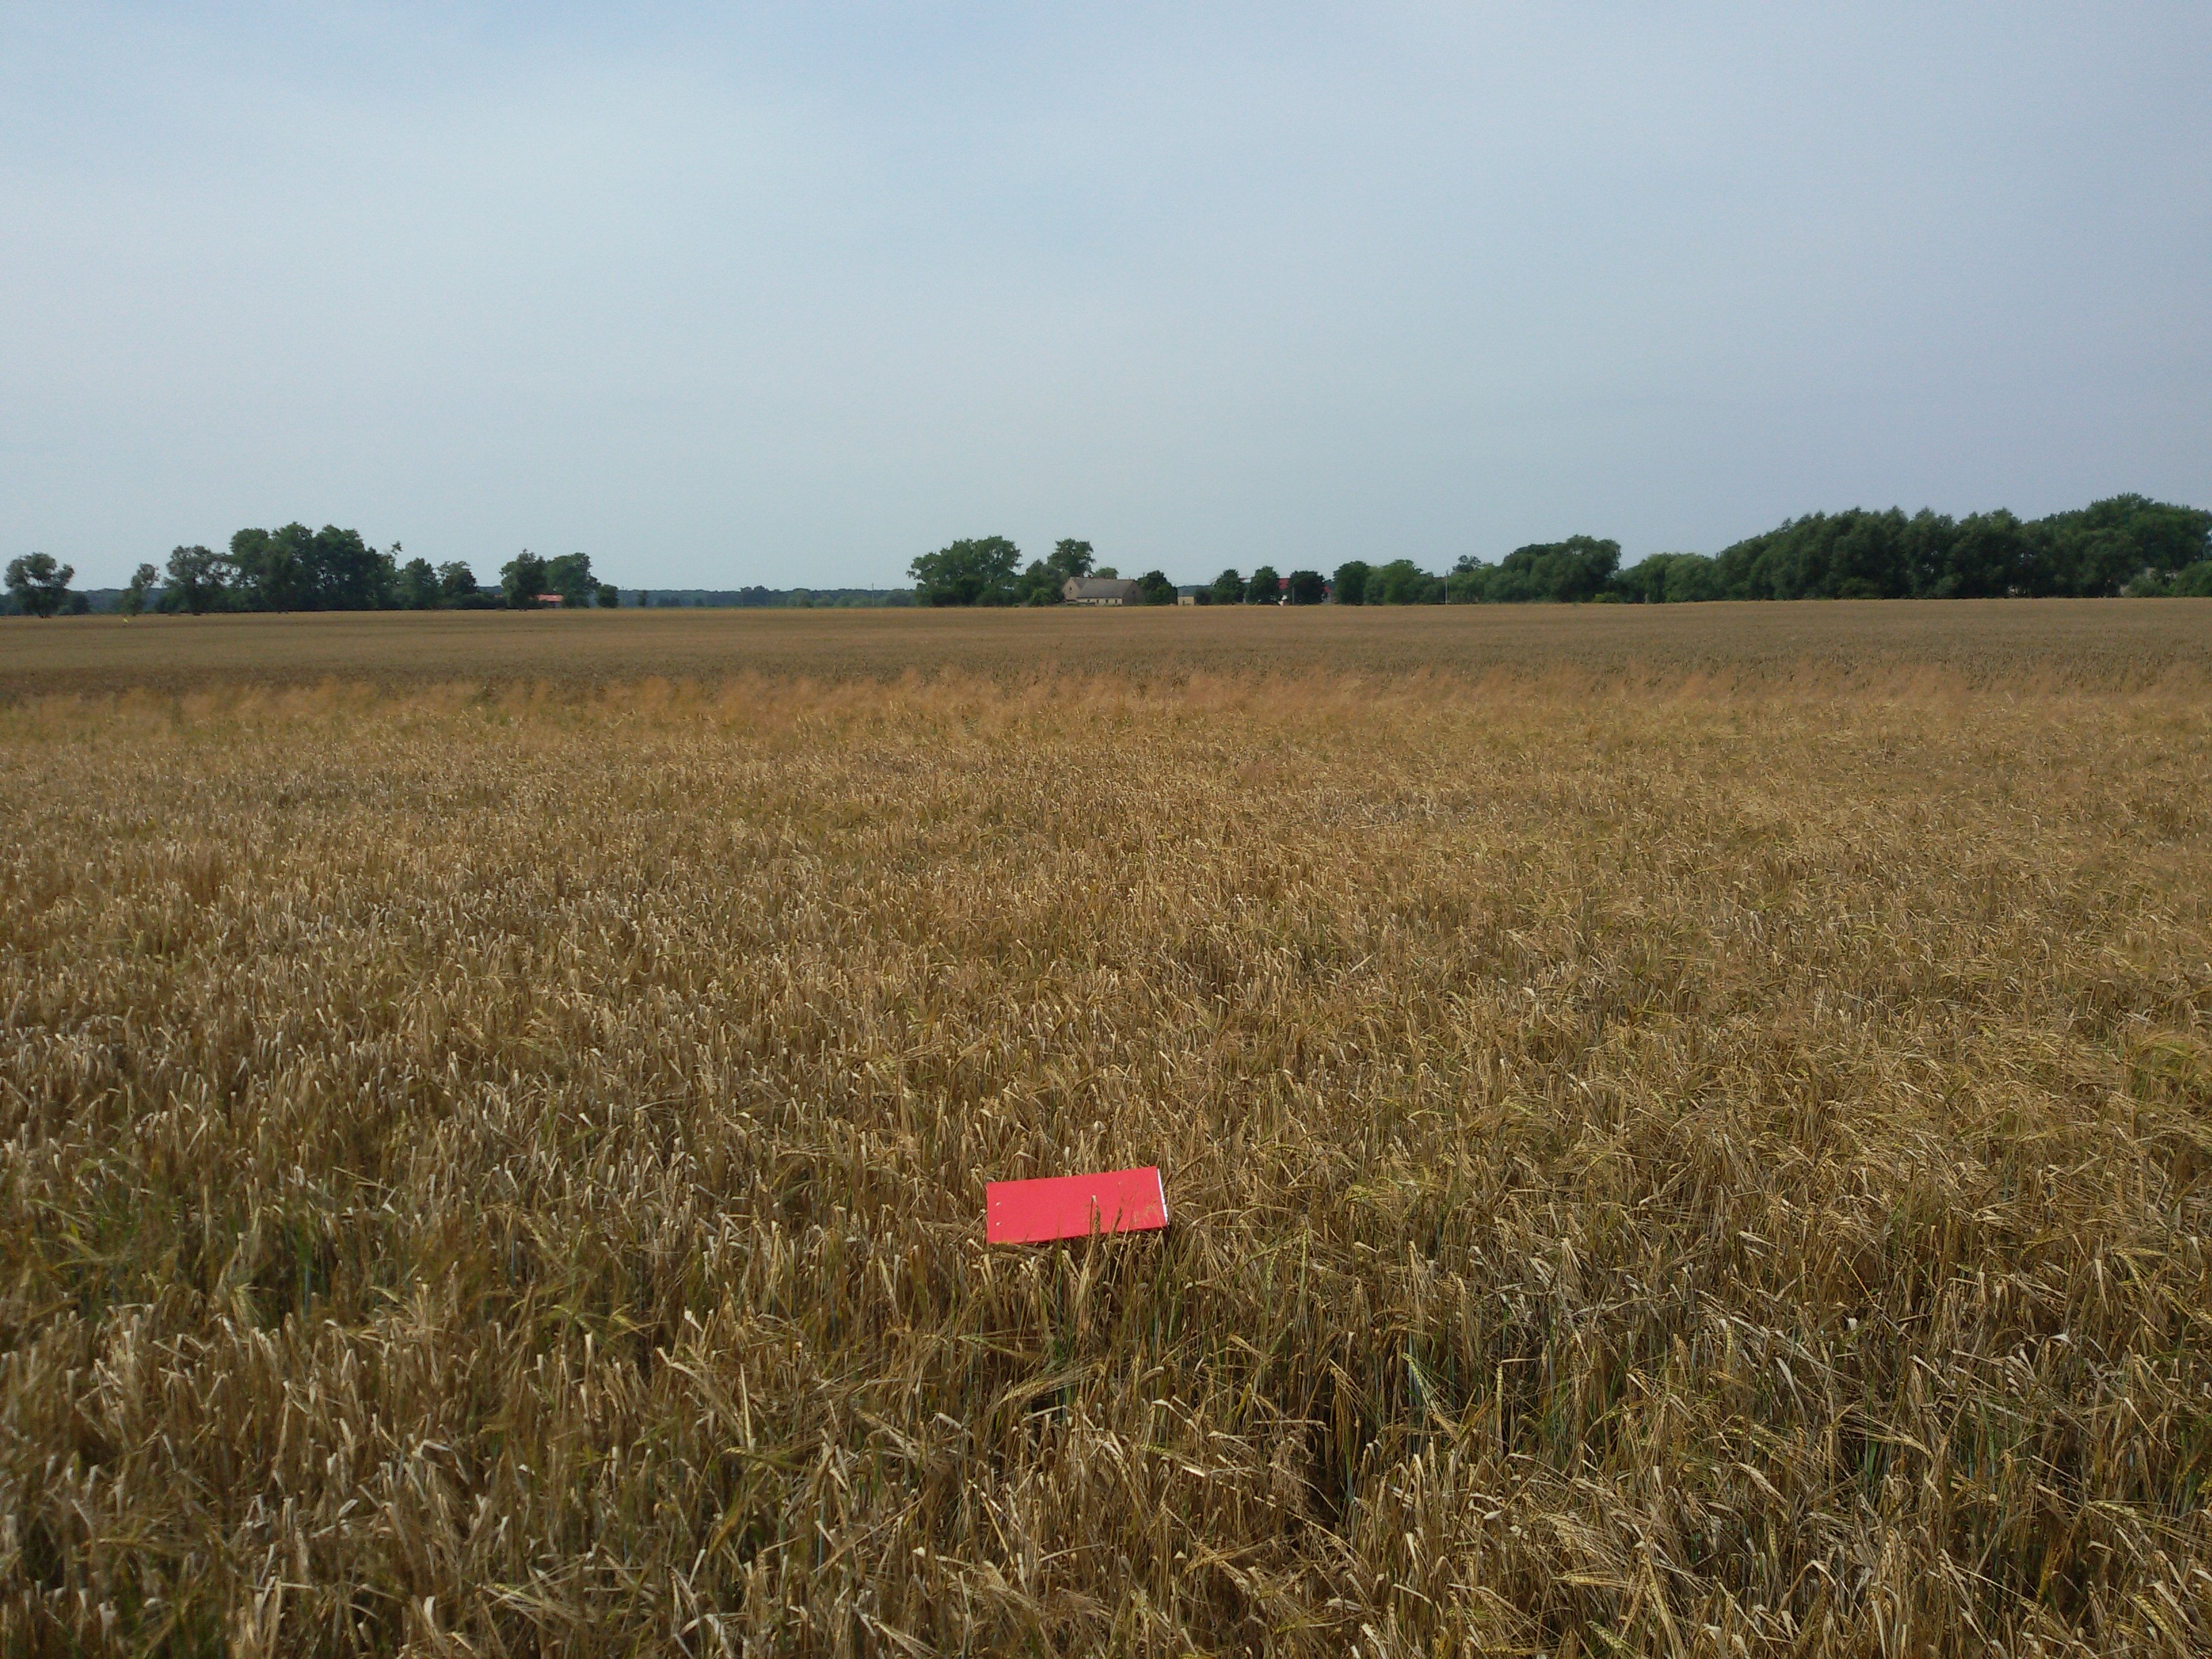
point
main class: Cropland
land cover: Barley
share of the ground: > 75 %
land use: Agriculture (excluding fallow land and kitchen gardens)
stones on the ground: < 10 %
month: July
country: PL
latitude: 52.4451
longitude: 17.5307
